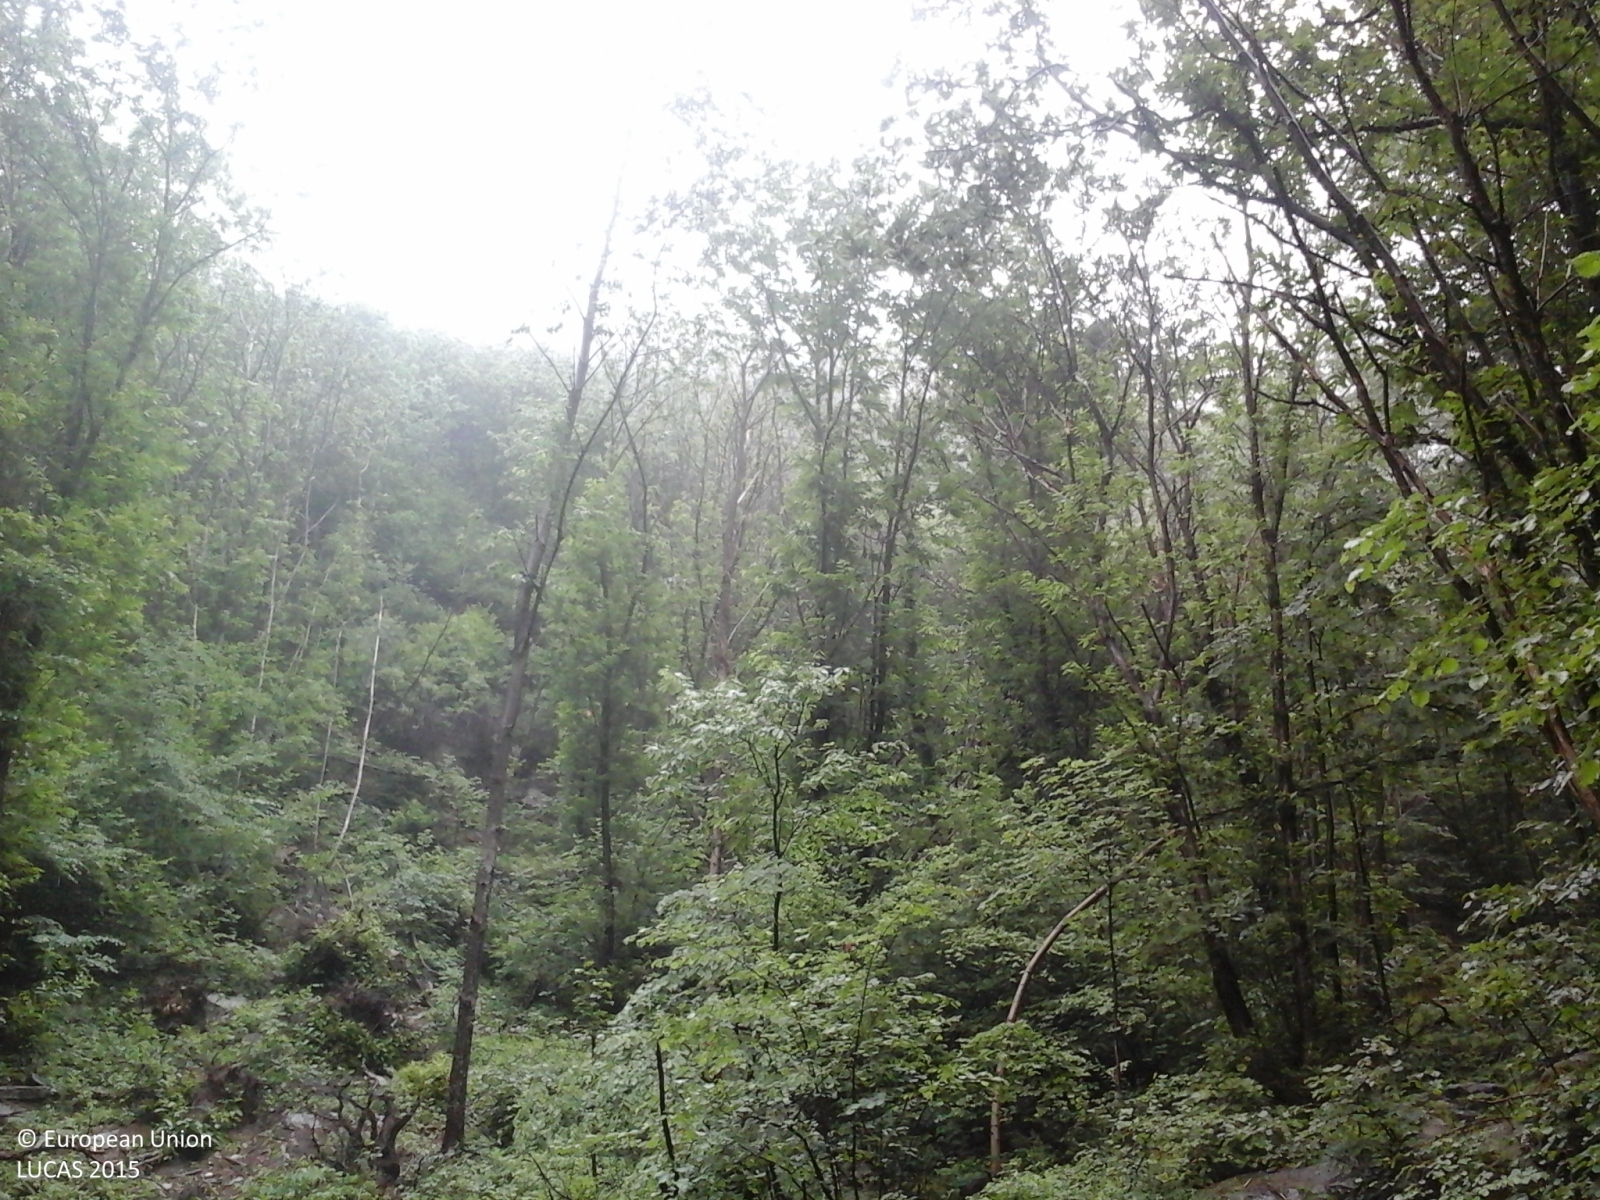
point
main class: Woodland
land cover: Broadleaved woodland
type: mesophytic deciduous forest
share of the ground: > 75 %
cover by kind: broadleaved forest trees 100 %
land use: Forestry
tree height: > 5 m
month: June
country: IT
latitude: 46.1932
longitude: 8.2789
